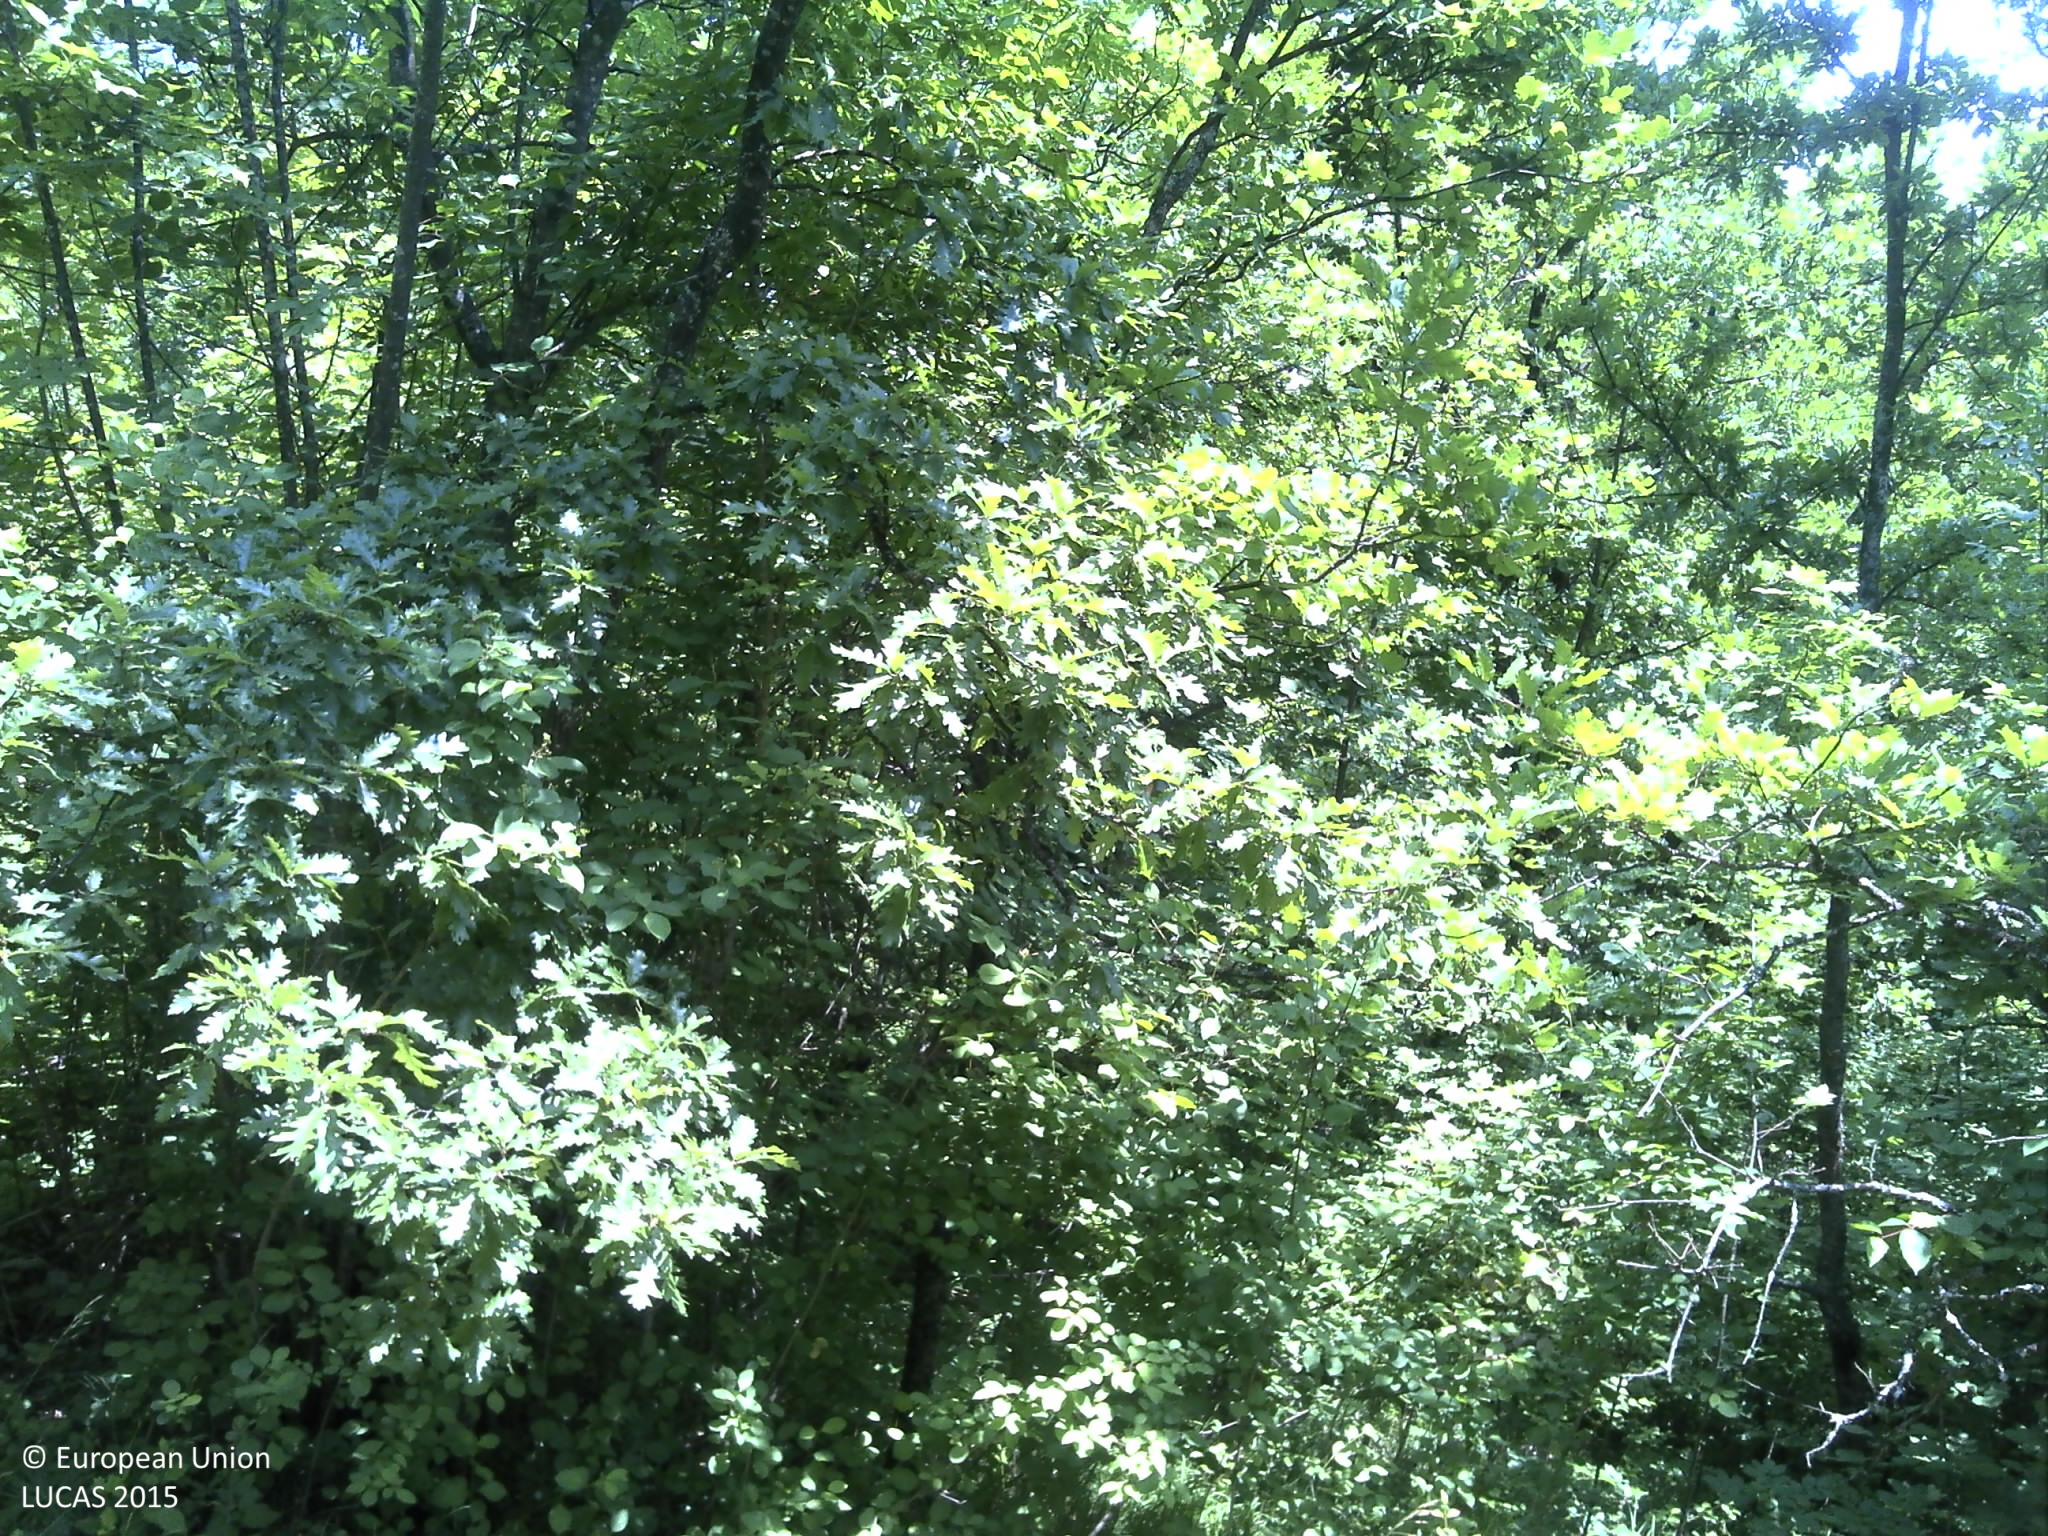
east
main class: Woodland
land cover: Broadleaved woodland
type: mountainous beech forest
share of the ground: > 75 %
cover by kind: broadleaved forest trees 90 %, herbaceous plants 10 %
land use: Forestry
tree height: > 5 m
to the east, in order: Broadleaved woodland; Grassland with sparse tree/shrub cover; Broadleaved woodland
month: June
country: HR
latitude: 44.5926
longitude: 16.0029
